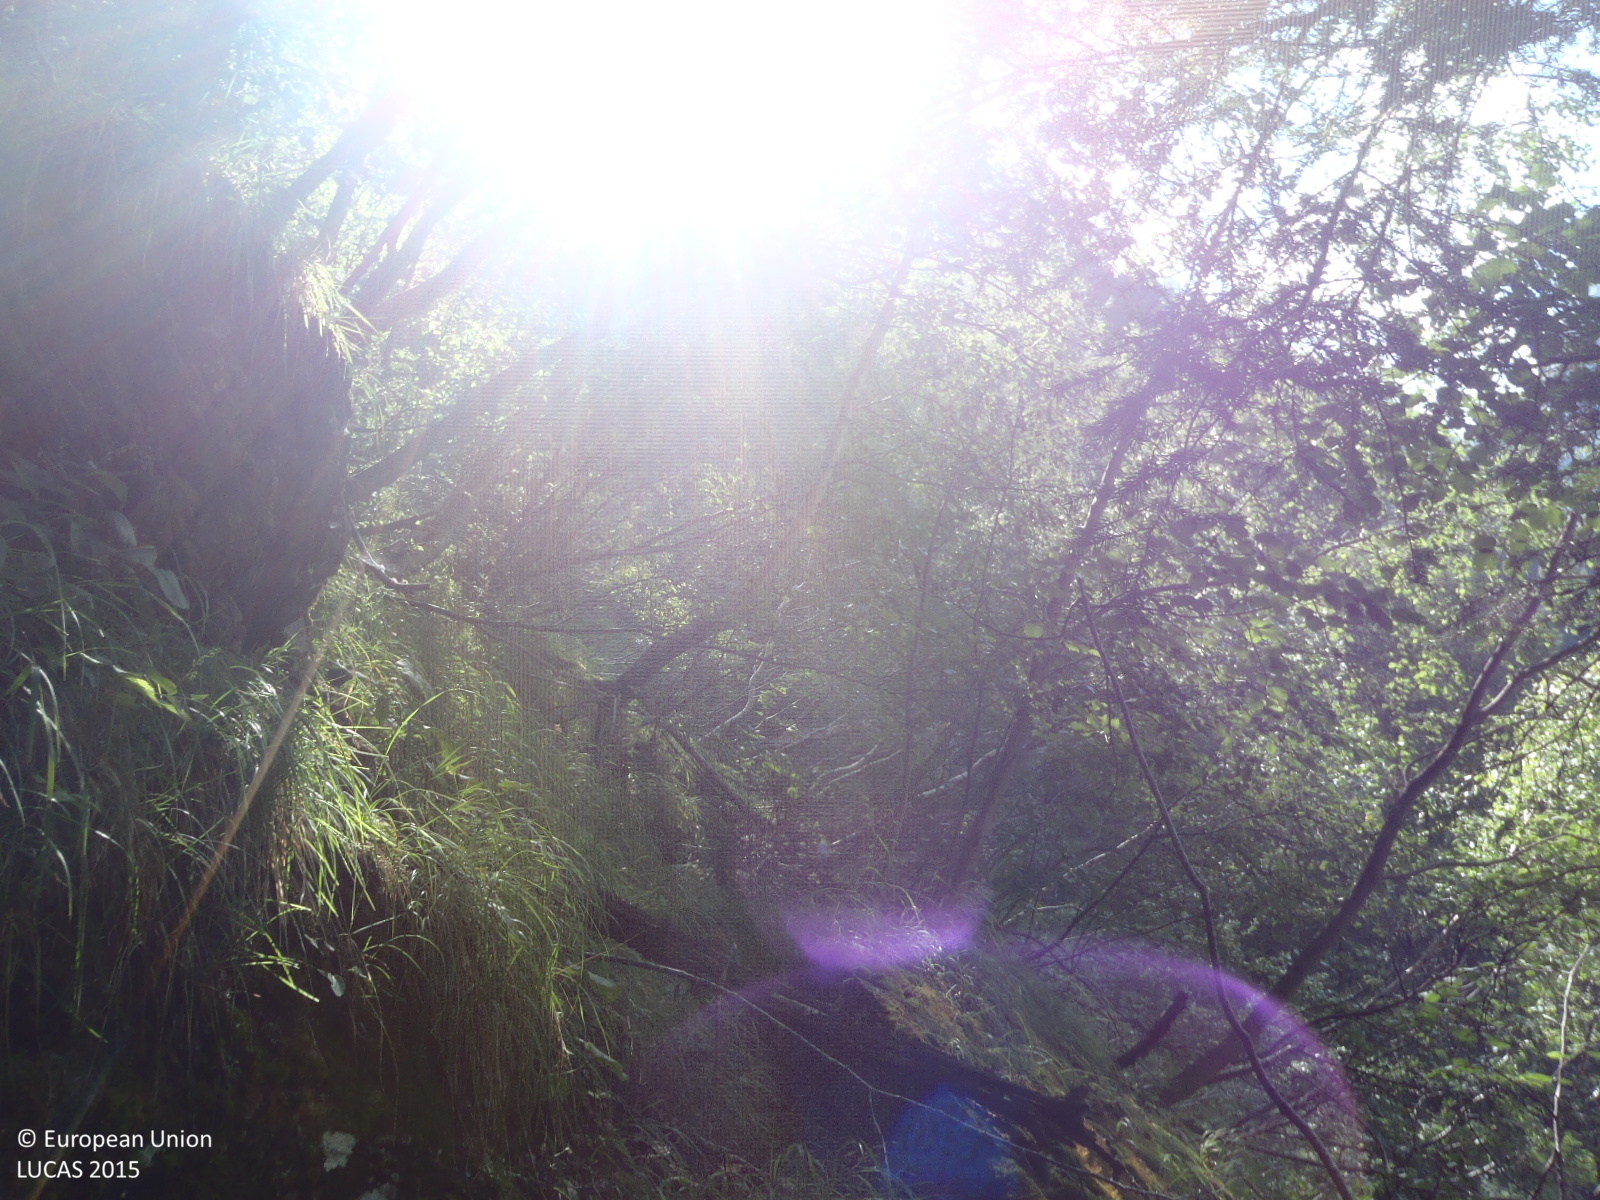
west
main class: Woodland
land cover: Broadleaved woodland
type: mesophytic deciduous forest
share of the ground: > 75 %
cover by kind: broadleaved forest trees 90 %, coniferous forest trees 10 %
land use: Semi-natural and natural areas not in use
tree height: > 5 m
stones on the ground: < 10 %
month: August
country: AT
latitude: 47.0105
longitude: 12.3261
